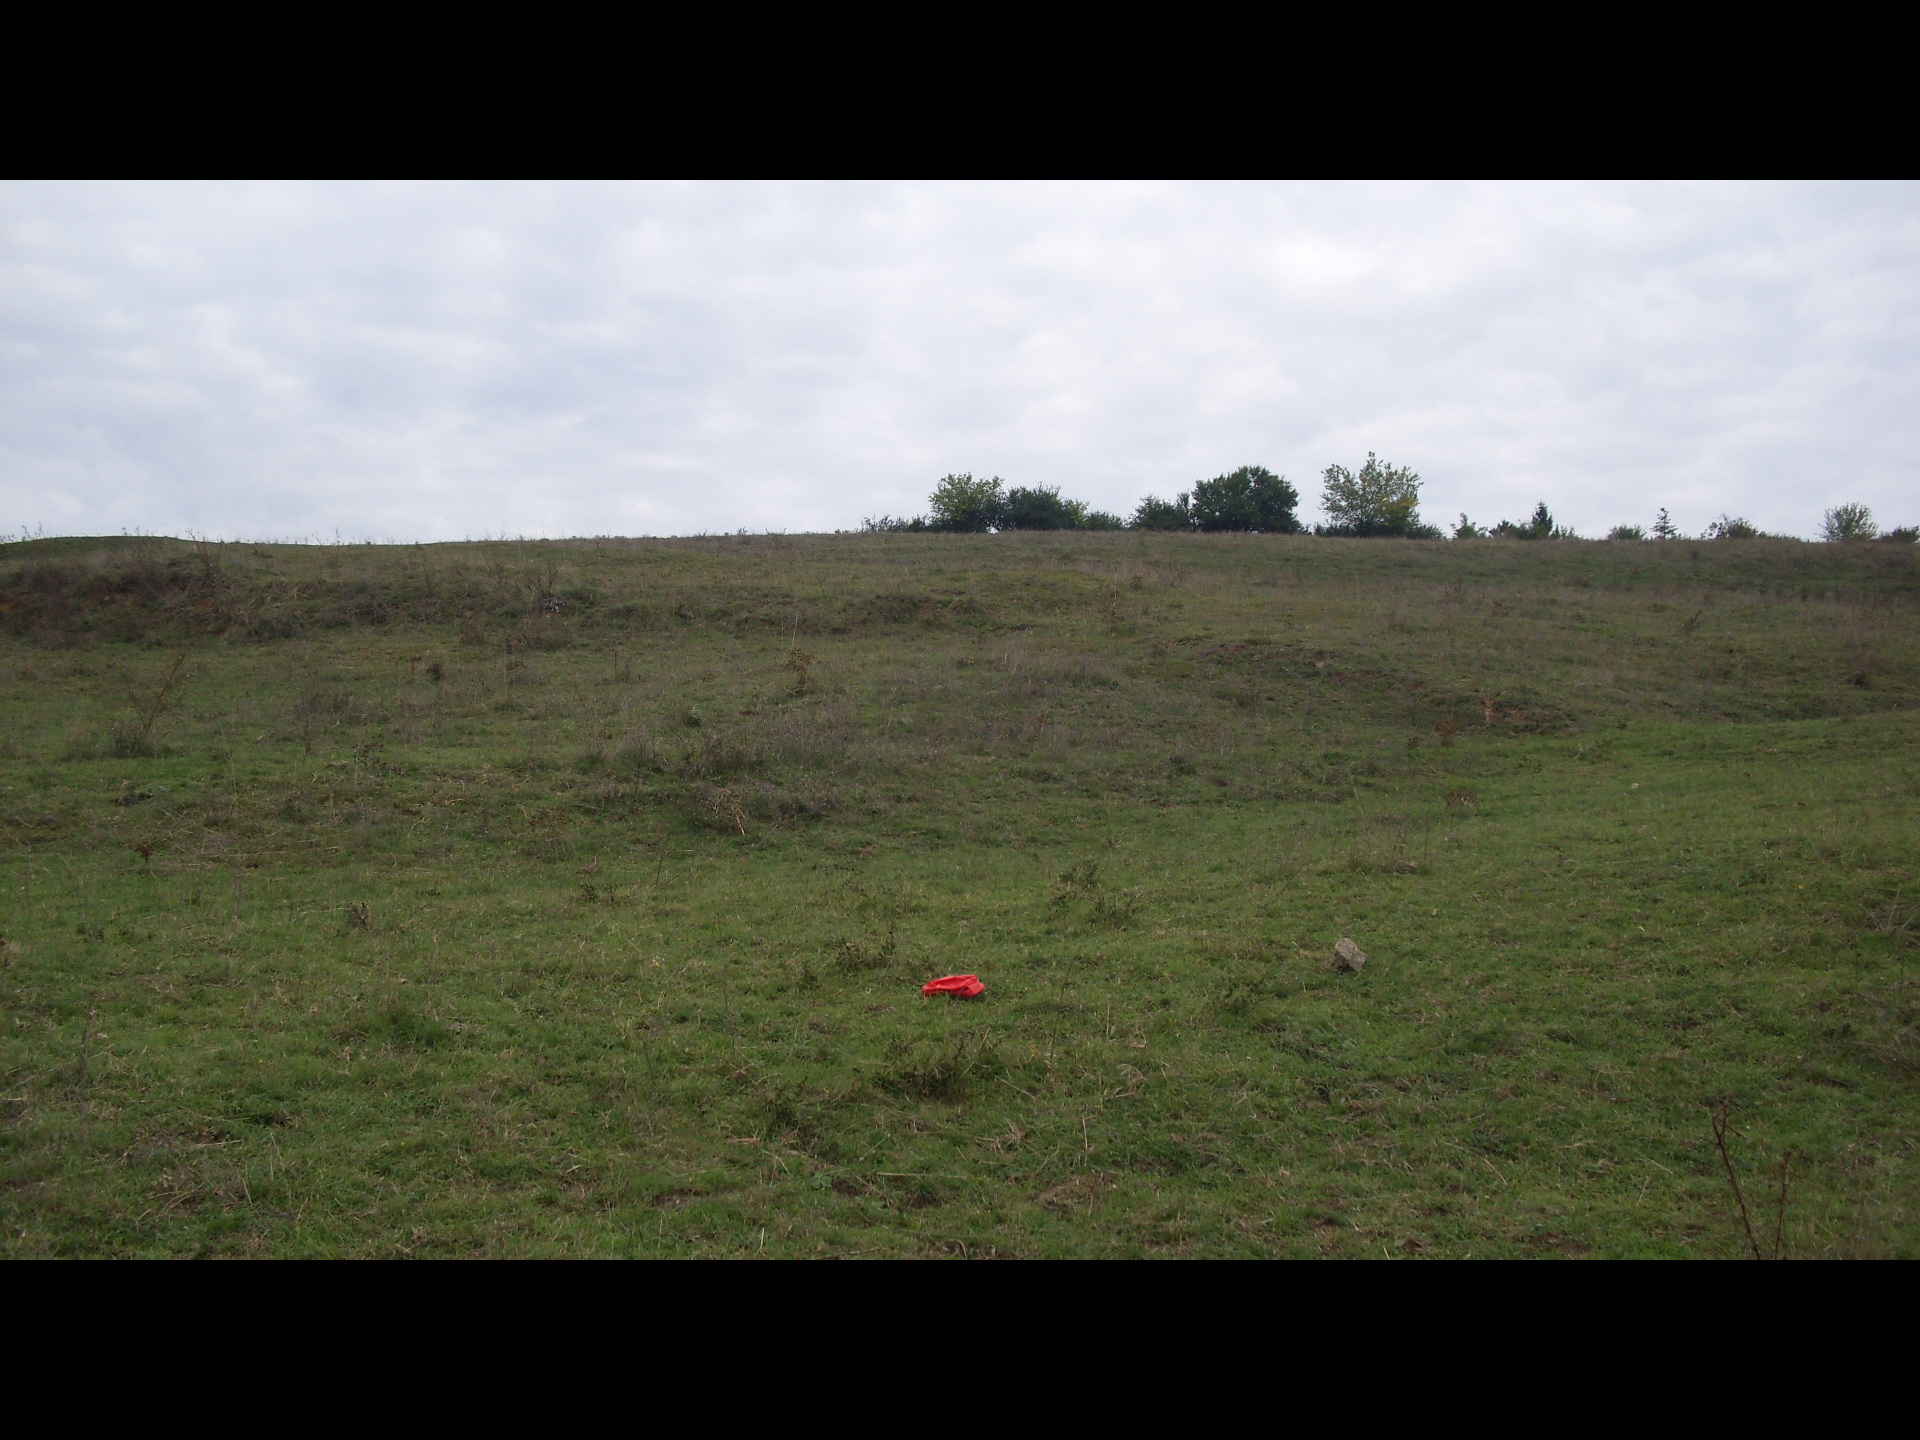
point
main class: Grassland
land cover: Grassland without tree/shrub cover
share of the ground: > 75 %
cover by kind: herbaceous plants 100 %
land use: Agriculture (excluding fallow land and kitchen gardens)
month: October
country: BG
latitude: 43.8811
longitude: 22.5171
